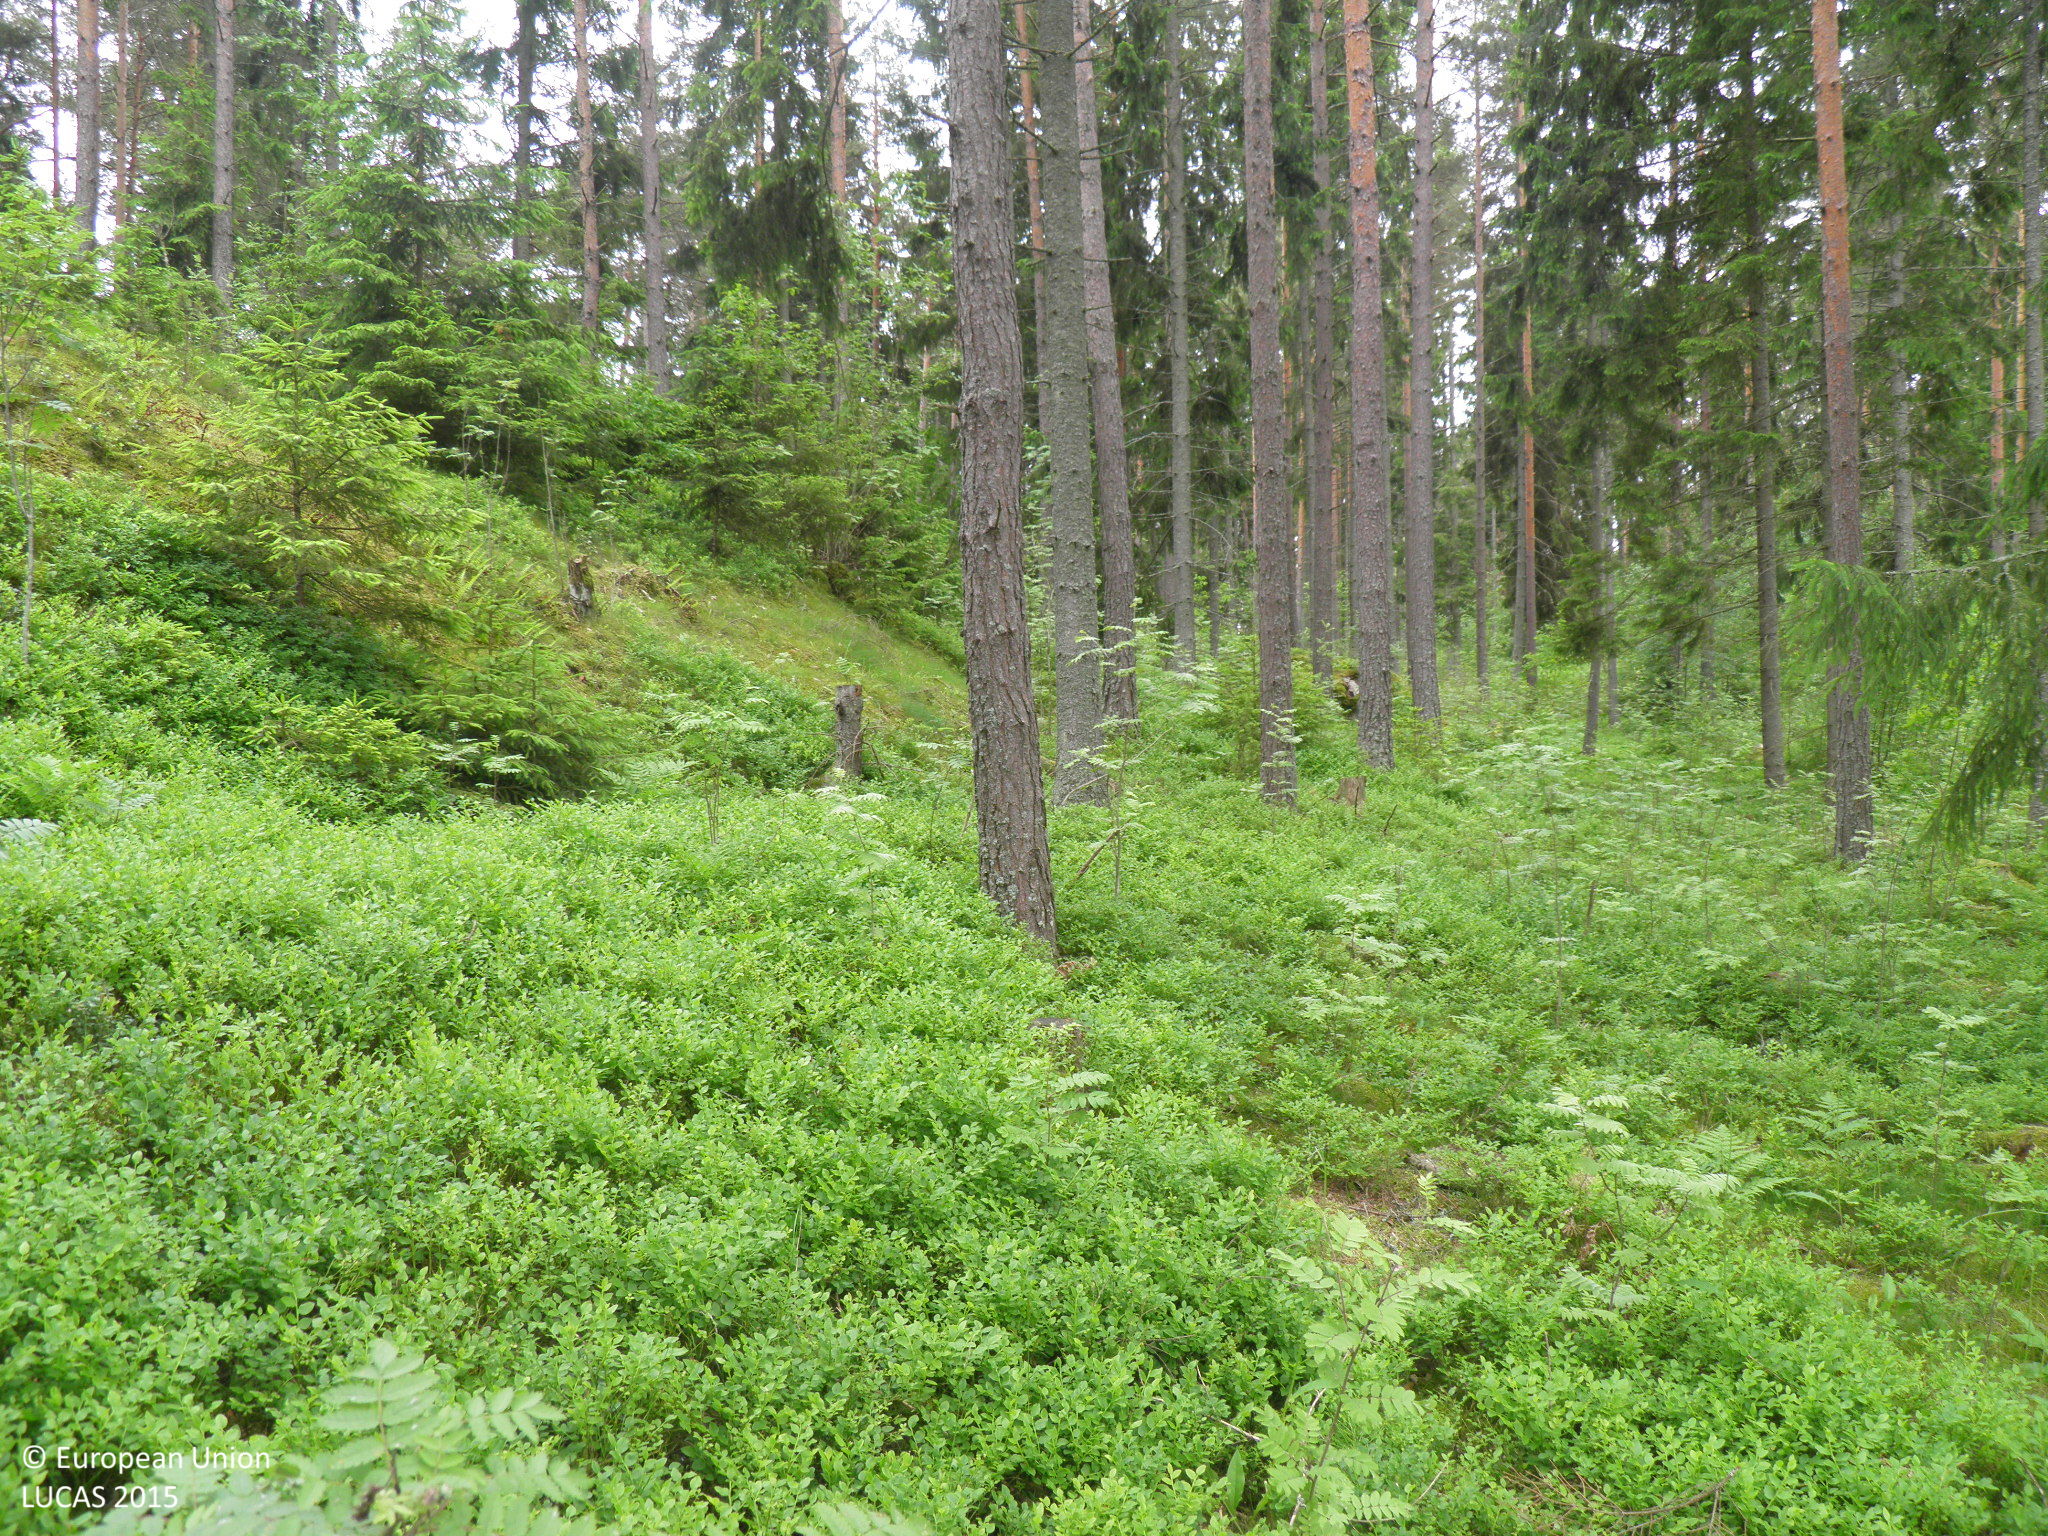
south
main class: Woodland
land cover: Other coniferous woodland
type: hemiboreal forest and nemoral coniferous forest and mixed broadleaved-coniferous forest
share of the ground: > 75 %
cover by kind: coniferous forest trees 70 %, broadleaved forest trees 10 %, shrubs 10 %, herbaceous plants 10 %
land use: Forestry
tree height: > 5 m
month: June
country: FI
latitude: 60.3079
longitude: 22.1746
